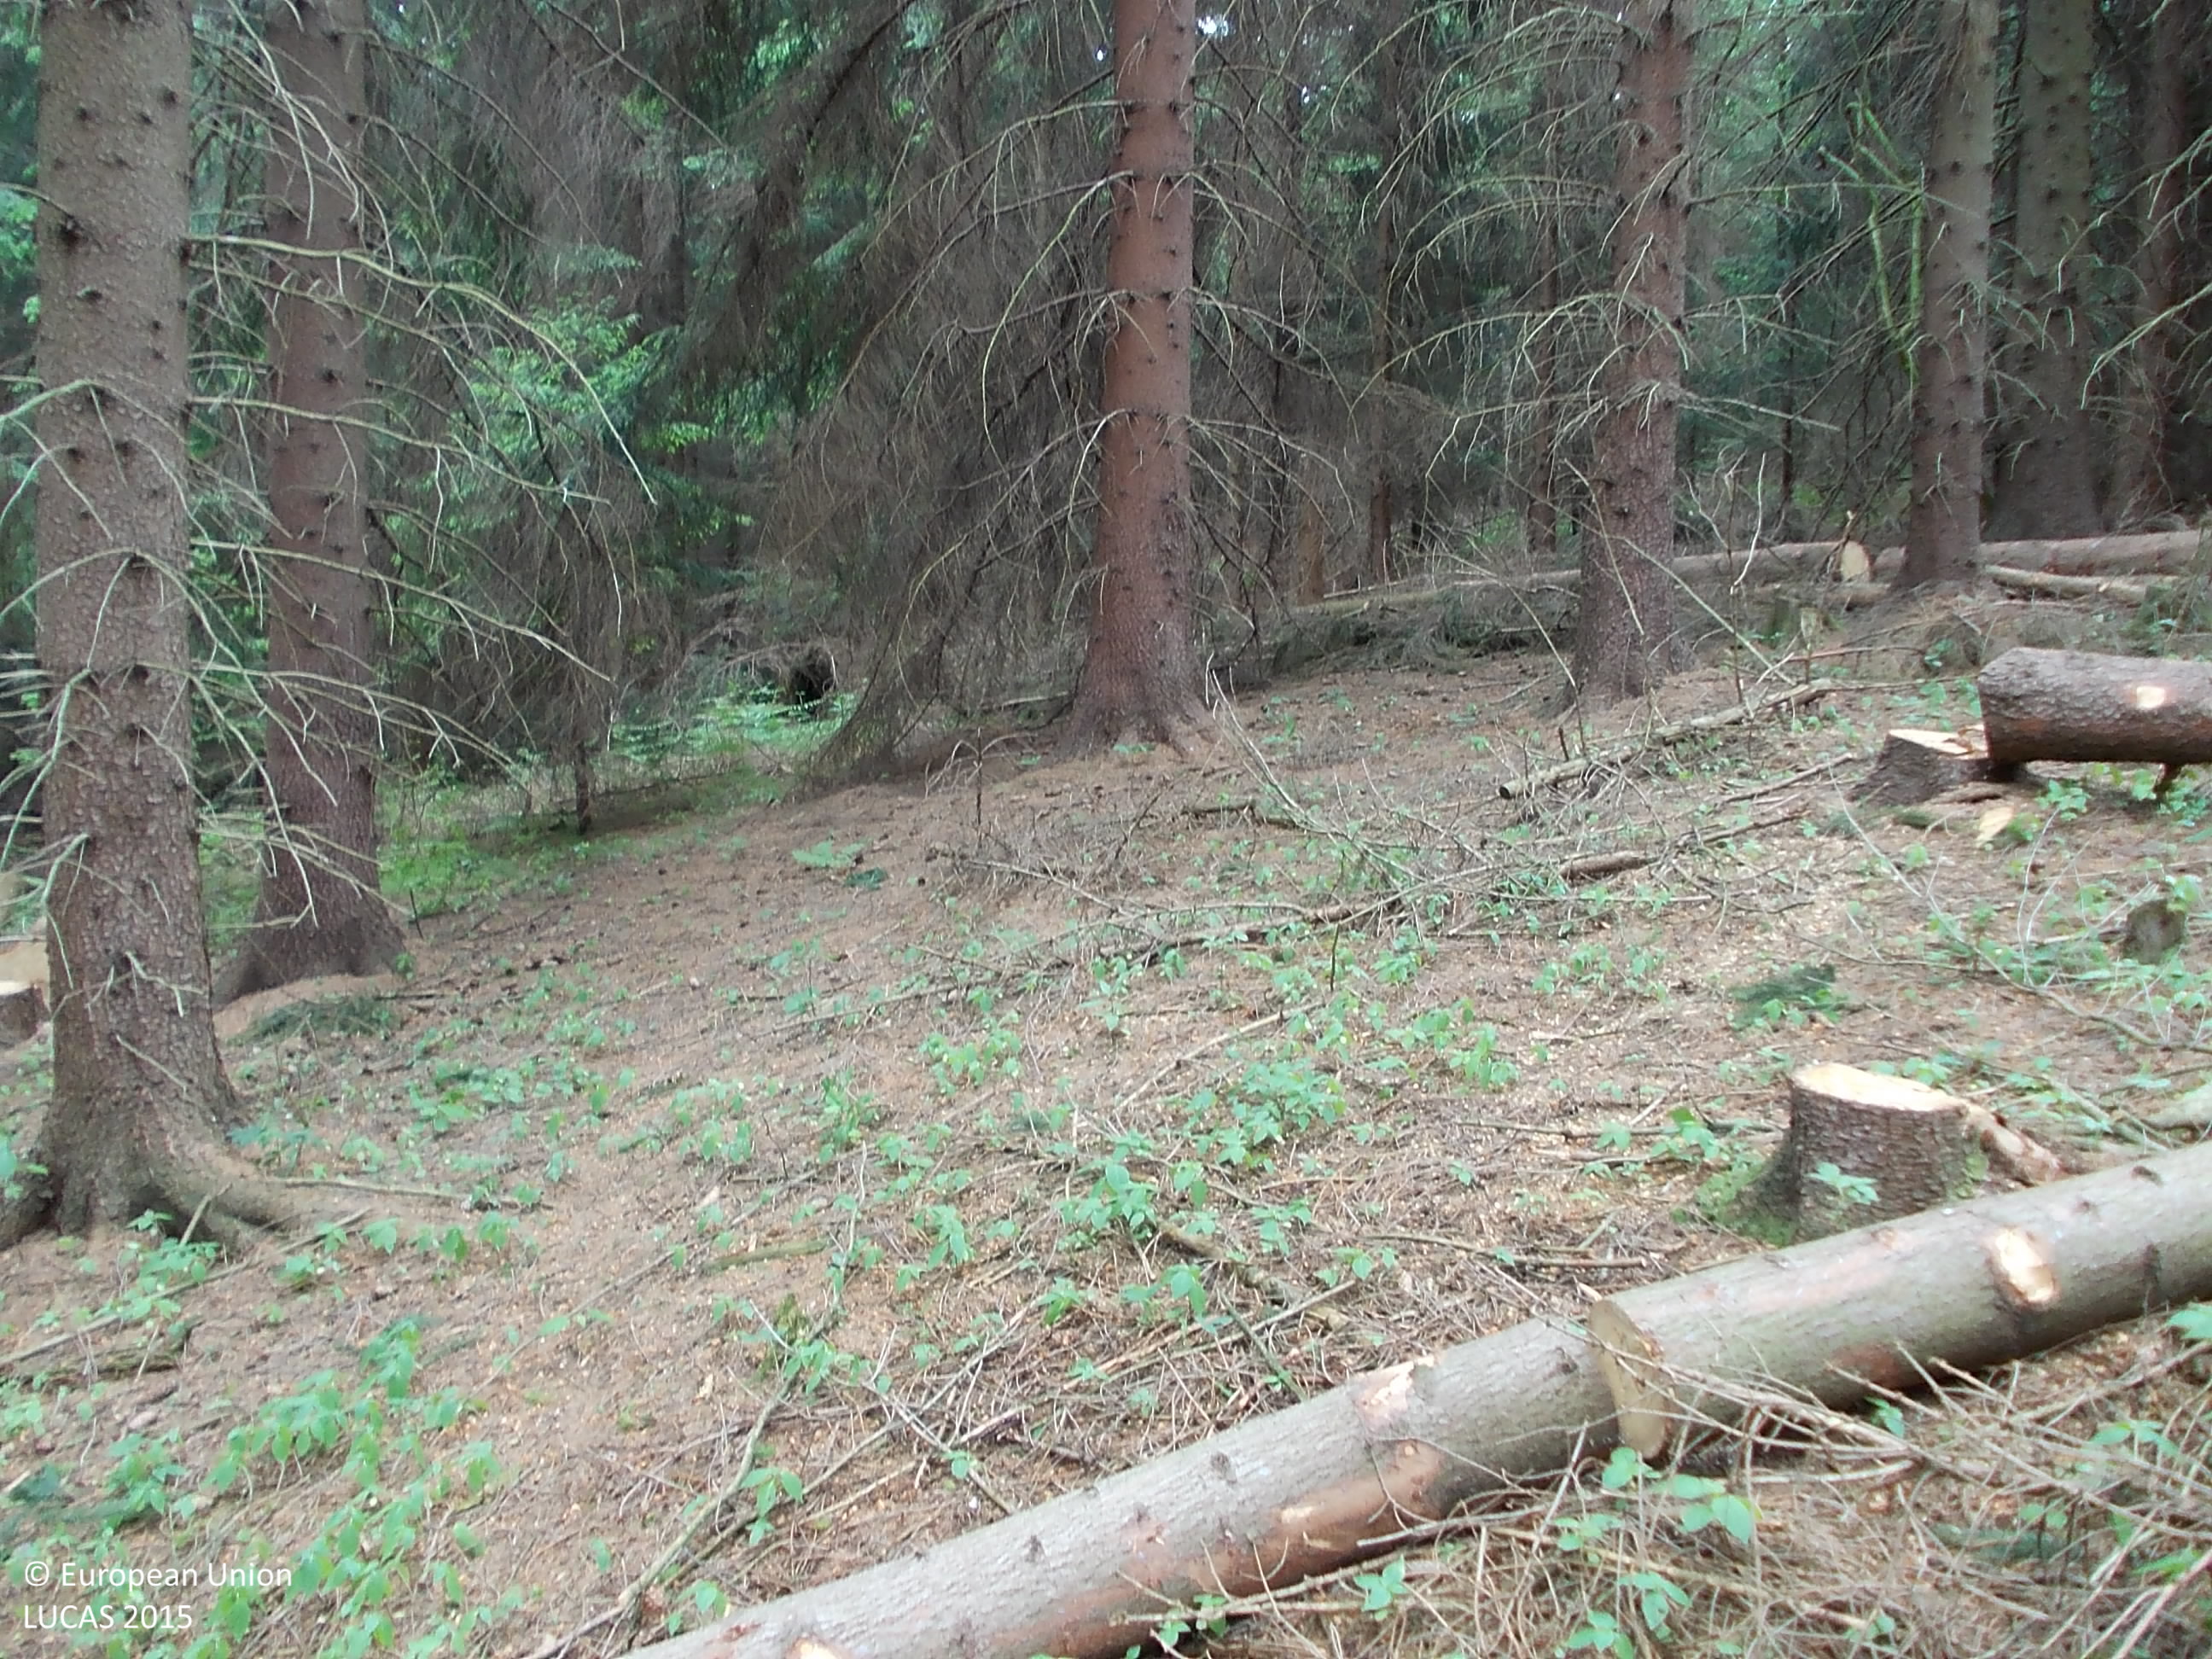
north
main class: Woodland
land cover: Spruce dominated coniferous woodland
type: hemiboreal forest and nemoral coniferous forest and mixed broadleaved-coniferous forest
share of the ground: > 75 %
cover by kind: coniferous forest trees 95 %, herbaceous plants 5 %
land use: Forestry
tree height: > 5 m
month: June
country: CZ
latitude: 50.2249
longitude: 16.3285
